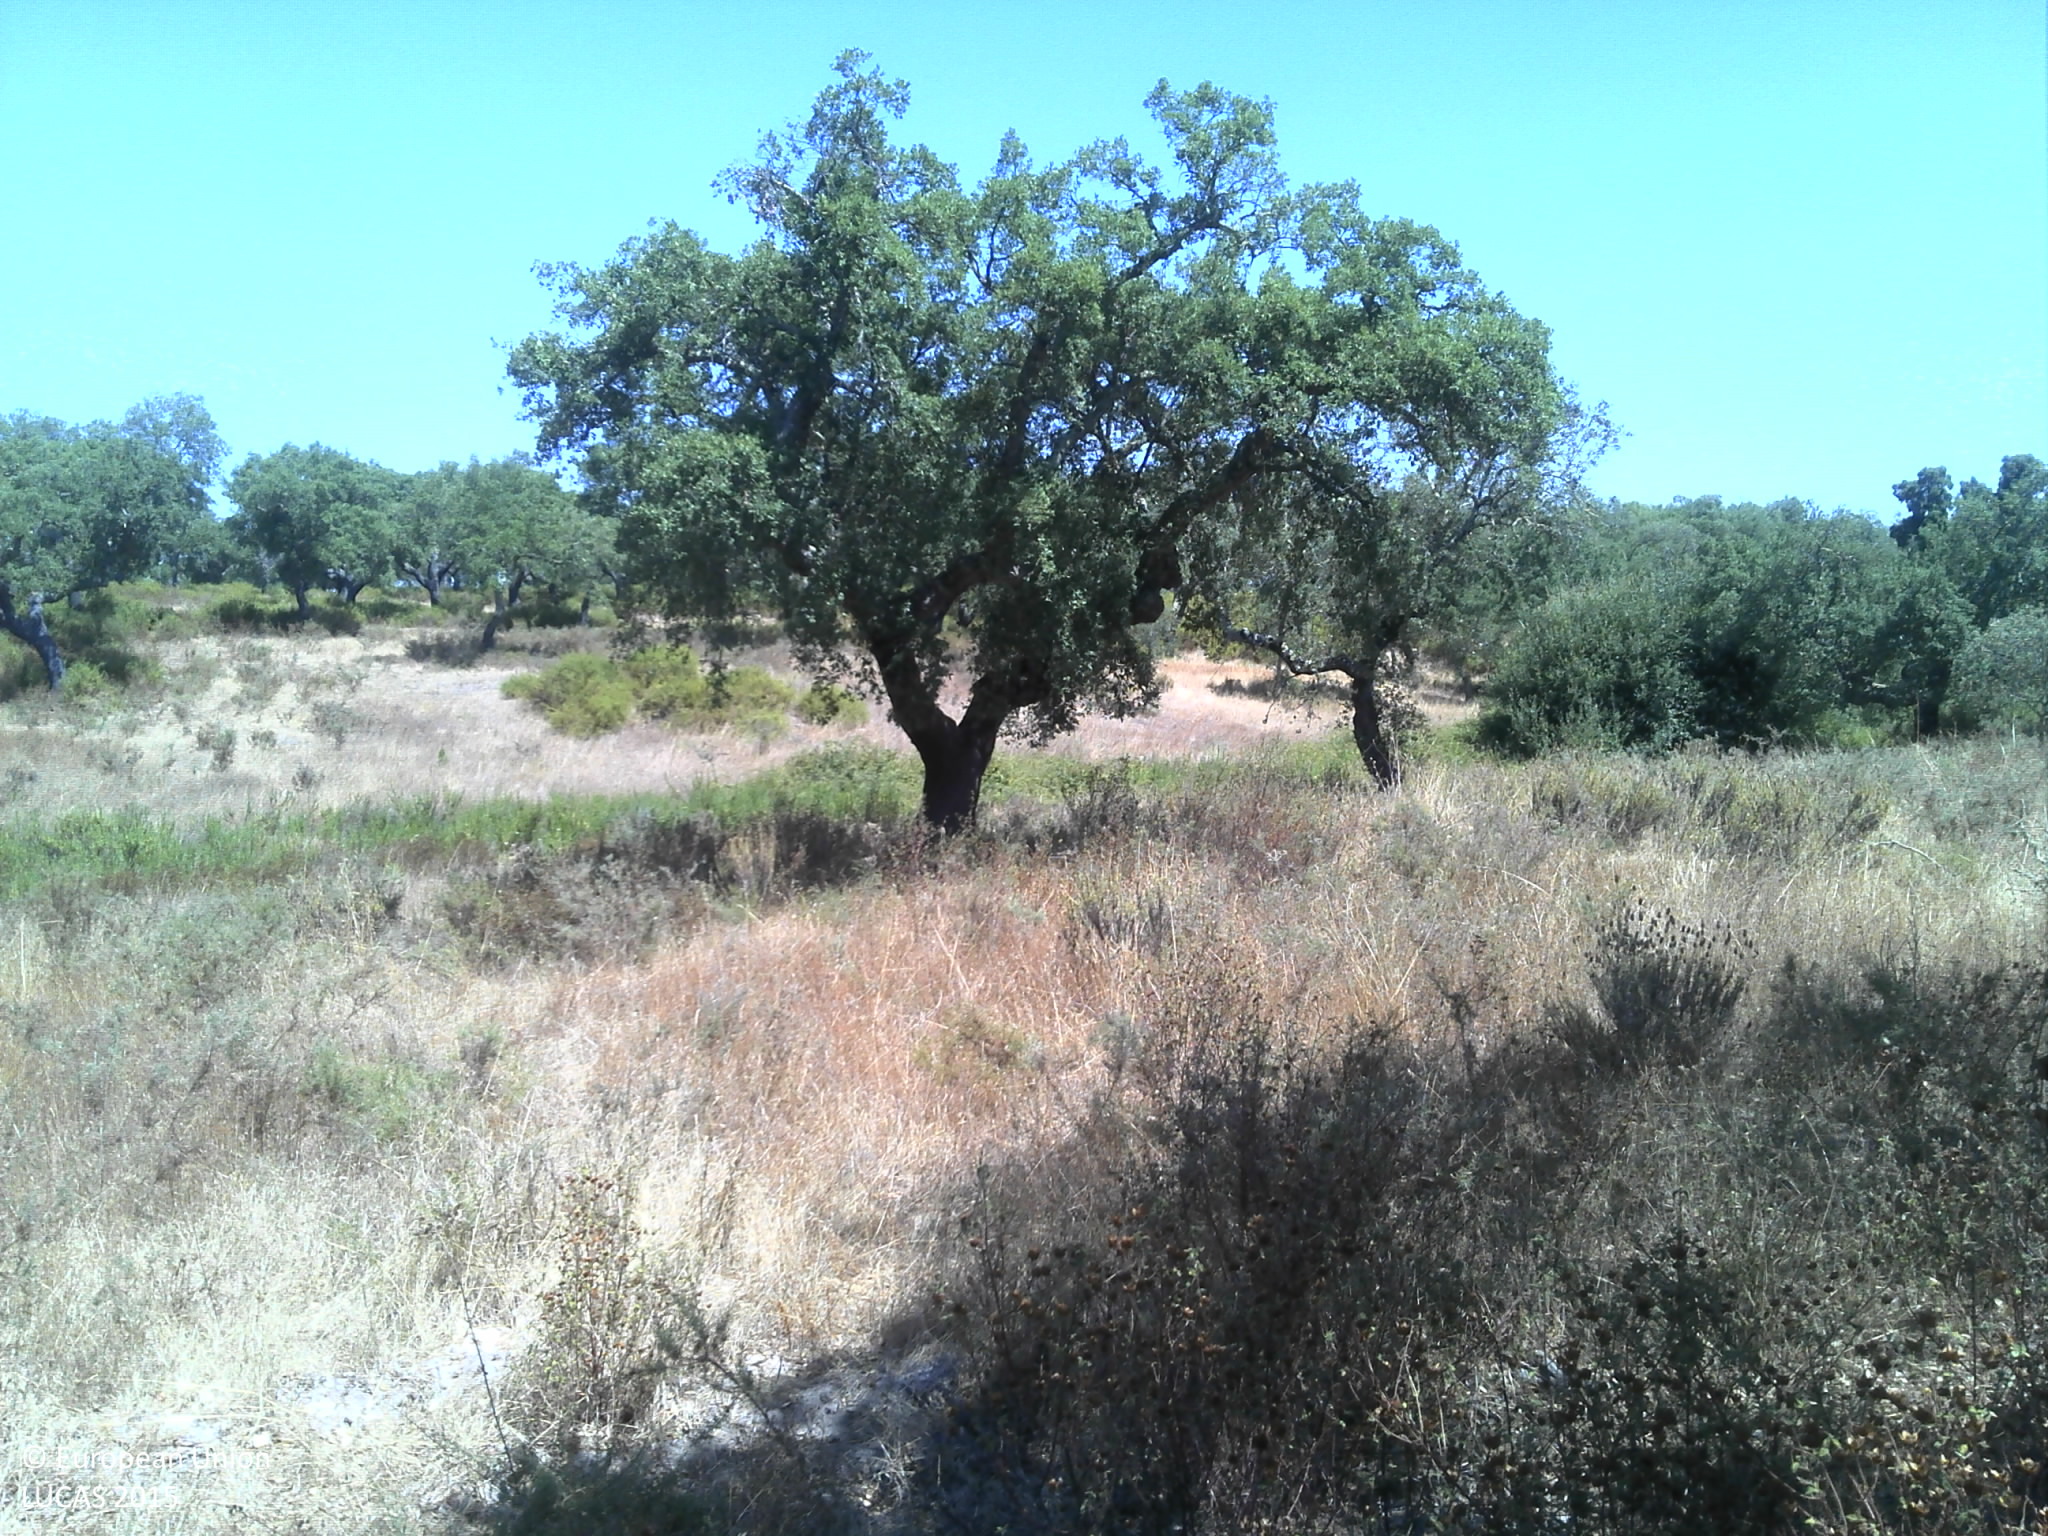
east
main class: Woodland
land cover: Broadleaved woodland
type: broadleaved evergreen forest
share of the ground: 25 - 50 %
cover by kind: broadleaved forest trees 45 %, unconsolidated bare surface 35 %, herbaceous plants 20 %
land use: Forestry
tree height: > 5 m
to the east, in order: Broadleaved woodland; Grassland without tree/shrub cover; Rivers and streams; Grassland without tree/shrub cover; Broadleaved woodland; Tracks; Broadleaved woodland
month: July
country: PT
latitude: 39.0157
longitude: -8.1755
